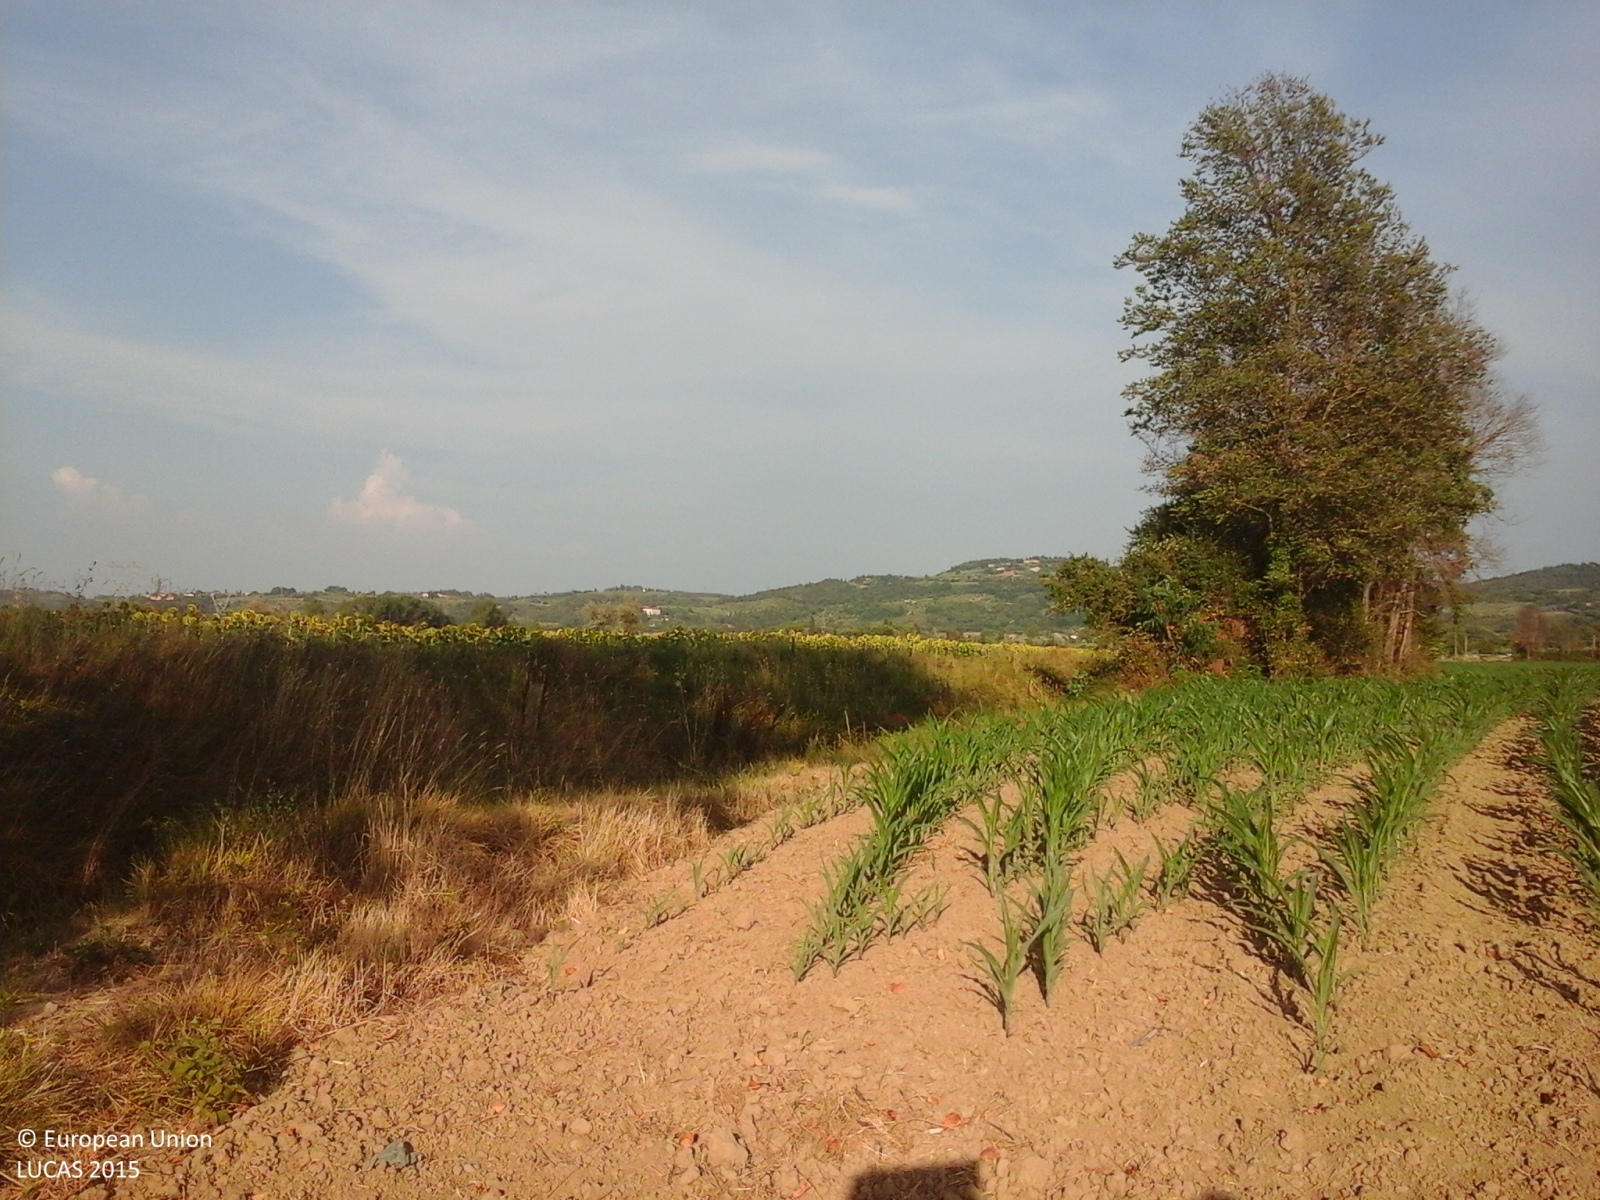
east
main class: Cropland
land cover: Maize
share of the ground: > 75 %
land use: Agriculture (excluding fallow land and kitchen gardens)
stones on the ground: < 10 %
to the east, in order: Maize; Grass margins; Ditches and canals; Grass margins; Maize; Ditches and canals; Tracks; Ditches and canals; Maize; Ditches and canals; Maize
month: July
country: IT
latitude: 43.7145
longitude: 10.9779
